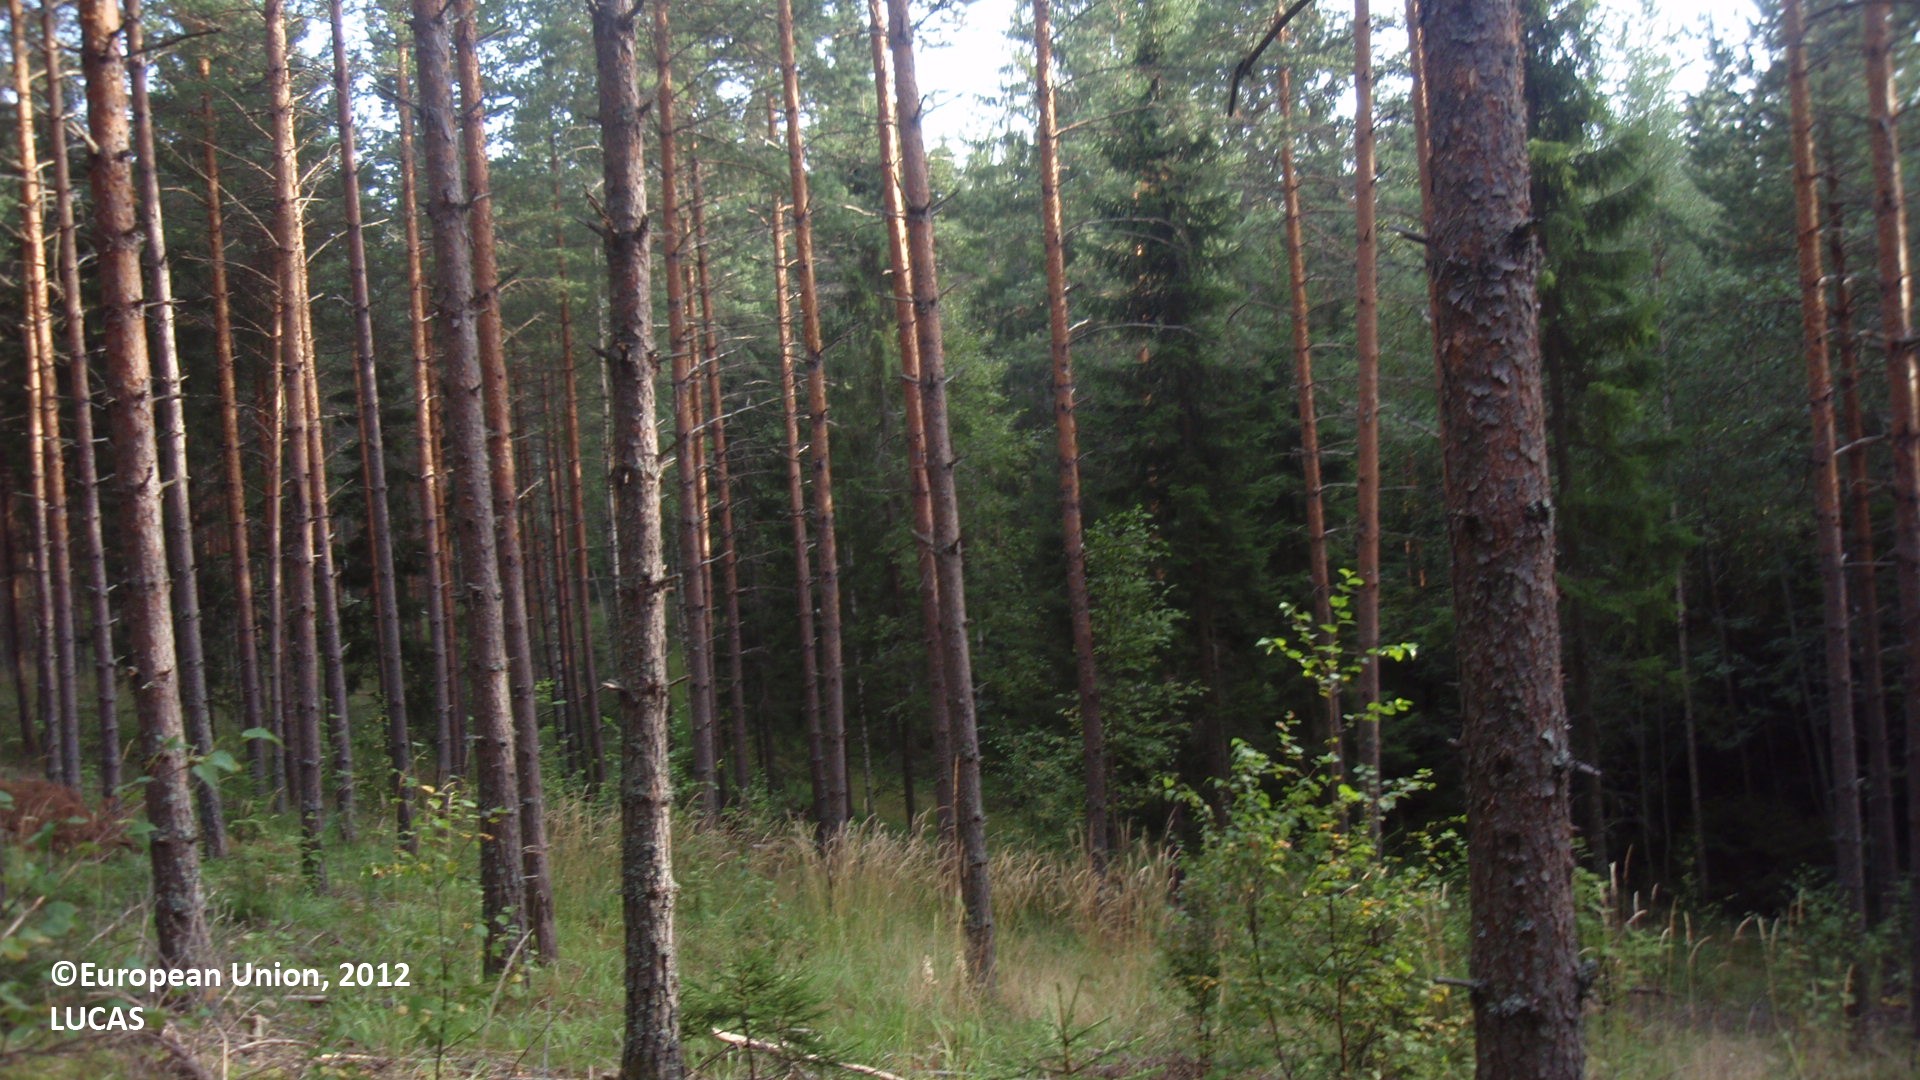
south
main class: Woodland
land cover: Pine dominated mixed woodland
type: boreal forest
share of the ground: 50 - 75 %
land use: Forestry
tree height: > 5 m
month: August
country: FI
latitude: 60.7248
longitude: 27.1684
